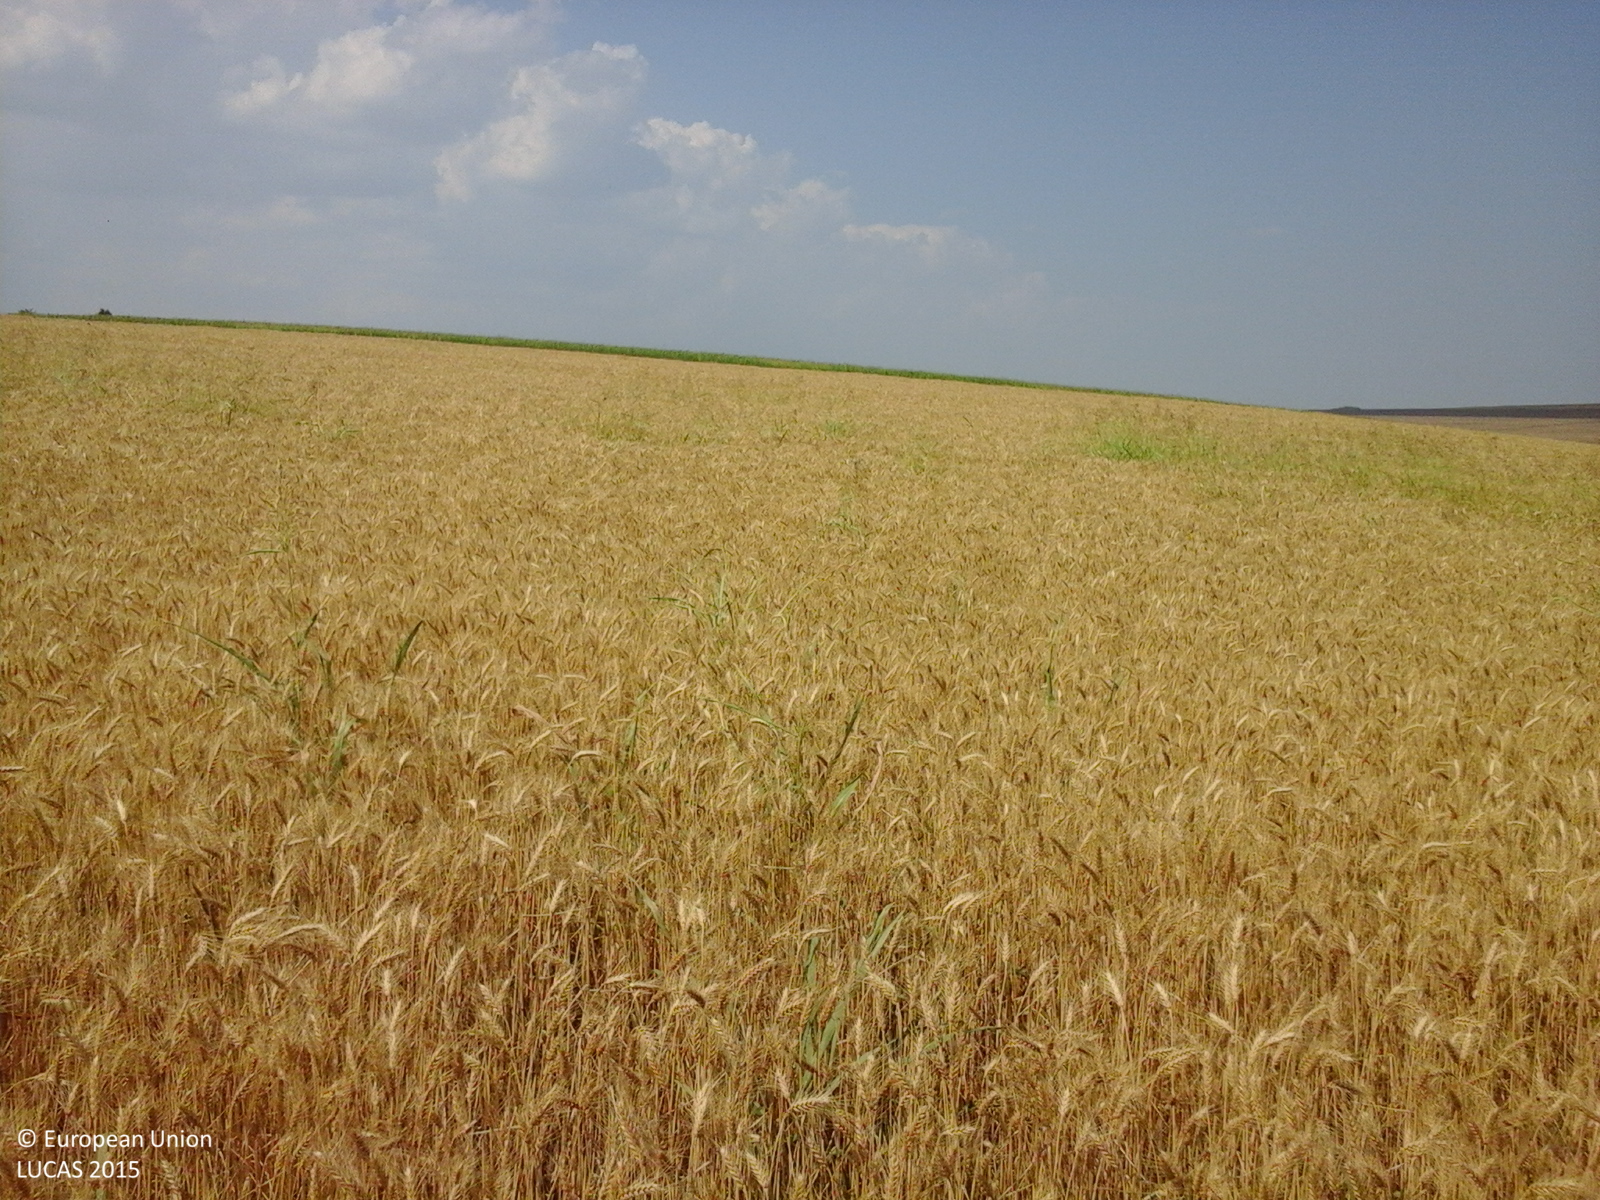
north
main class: Cropland
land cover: Durum wheat
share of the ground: > 75 %
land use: Agriculture (excluding fallow land and kitchen gardens)
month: July
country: RO
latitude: 45.9265
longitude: 28.0343
